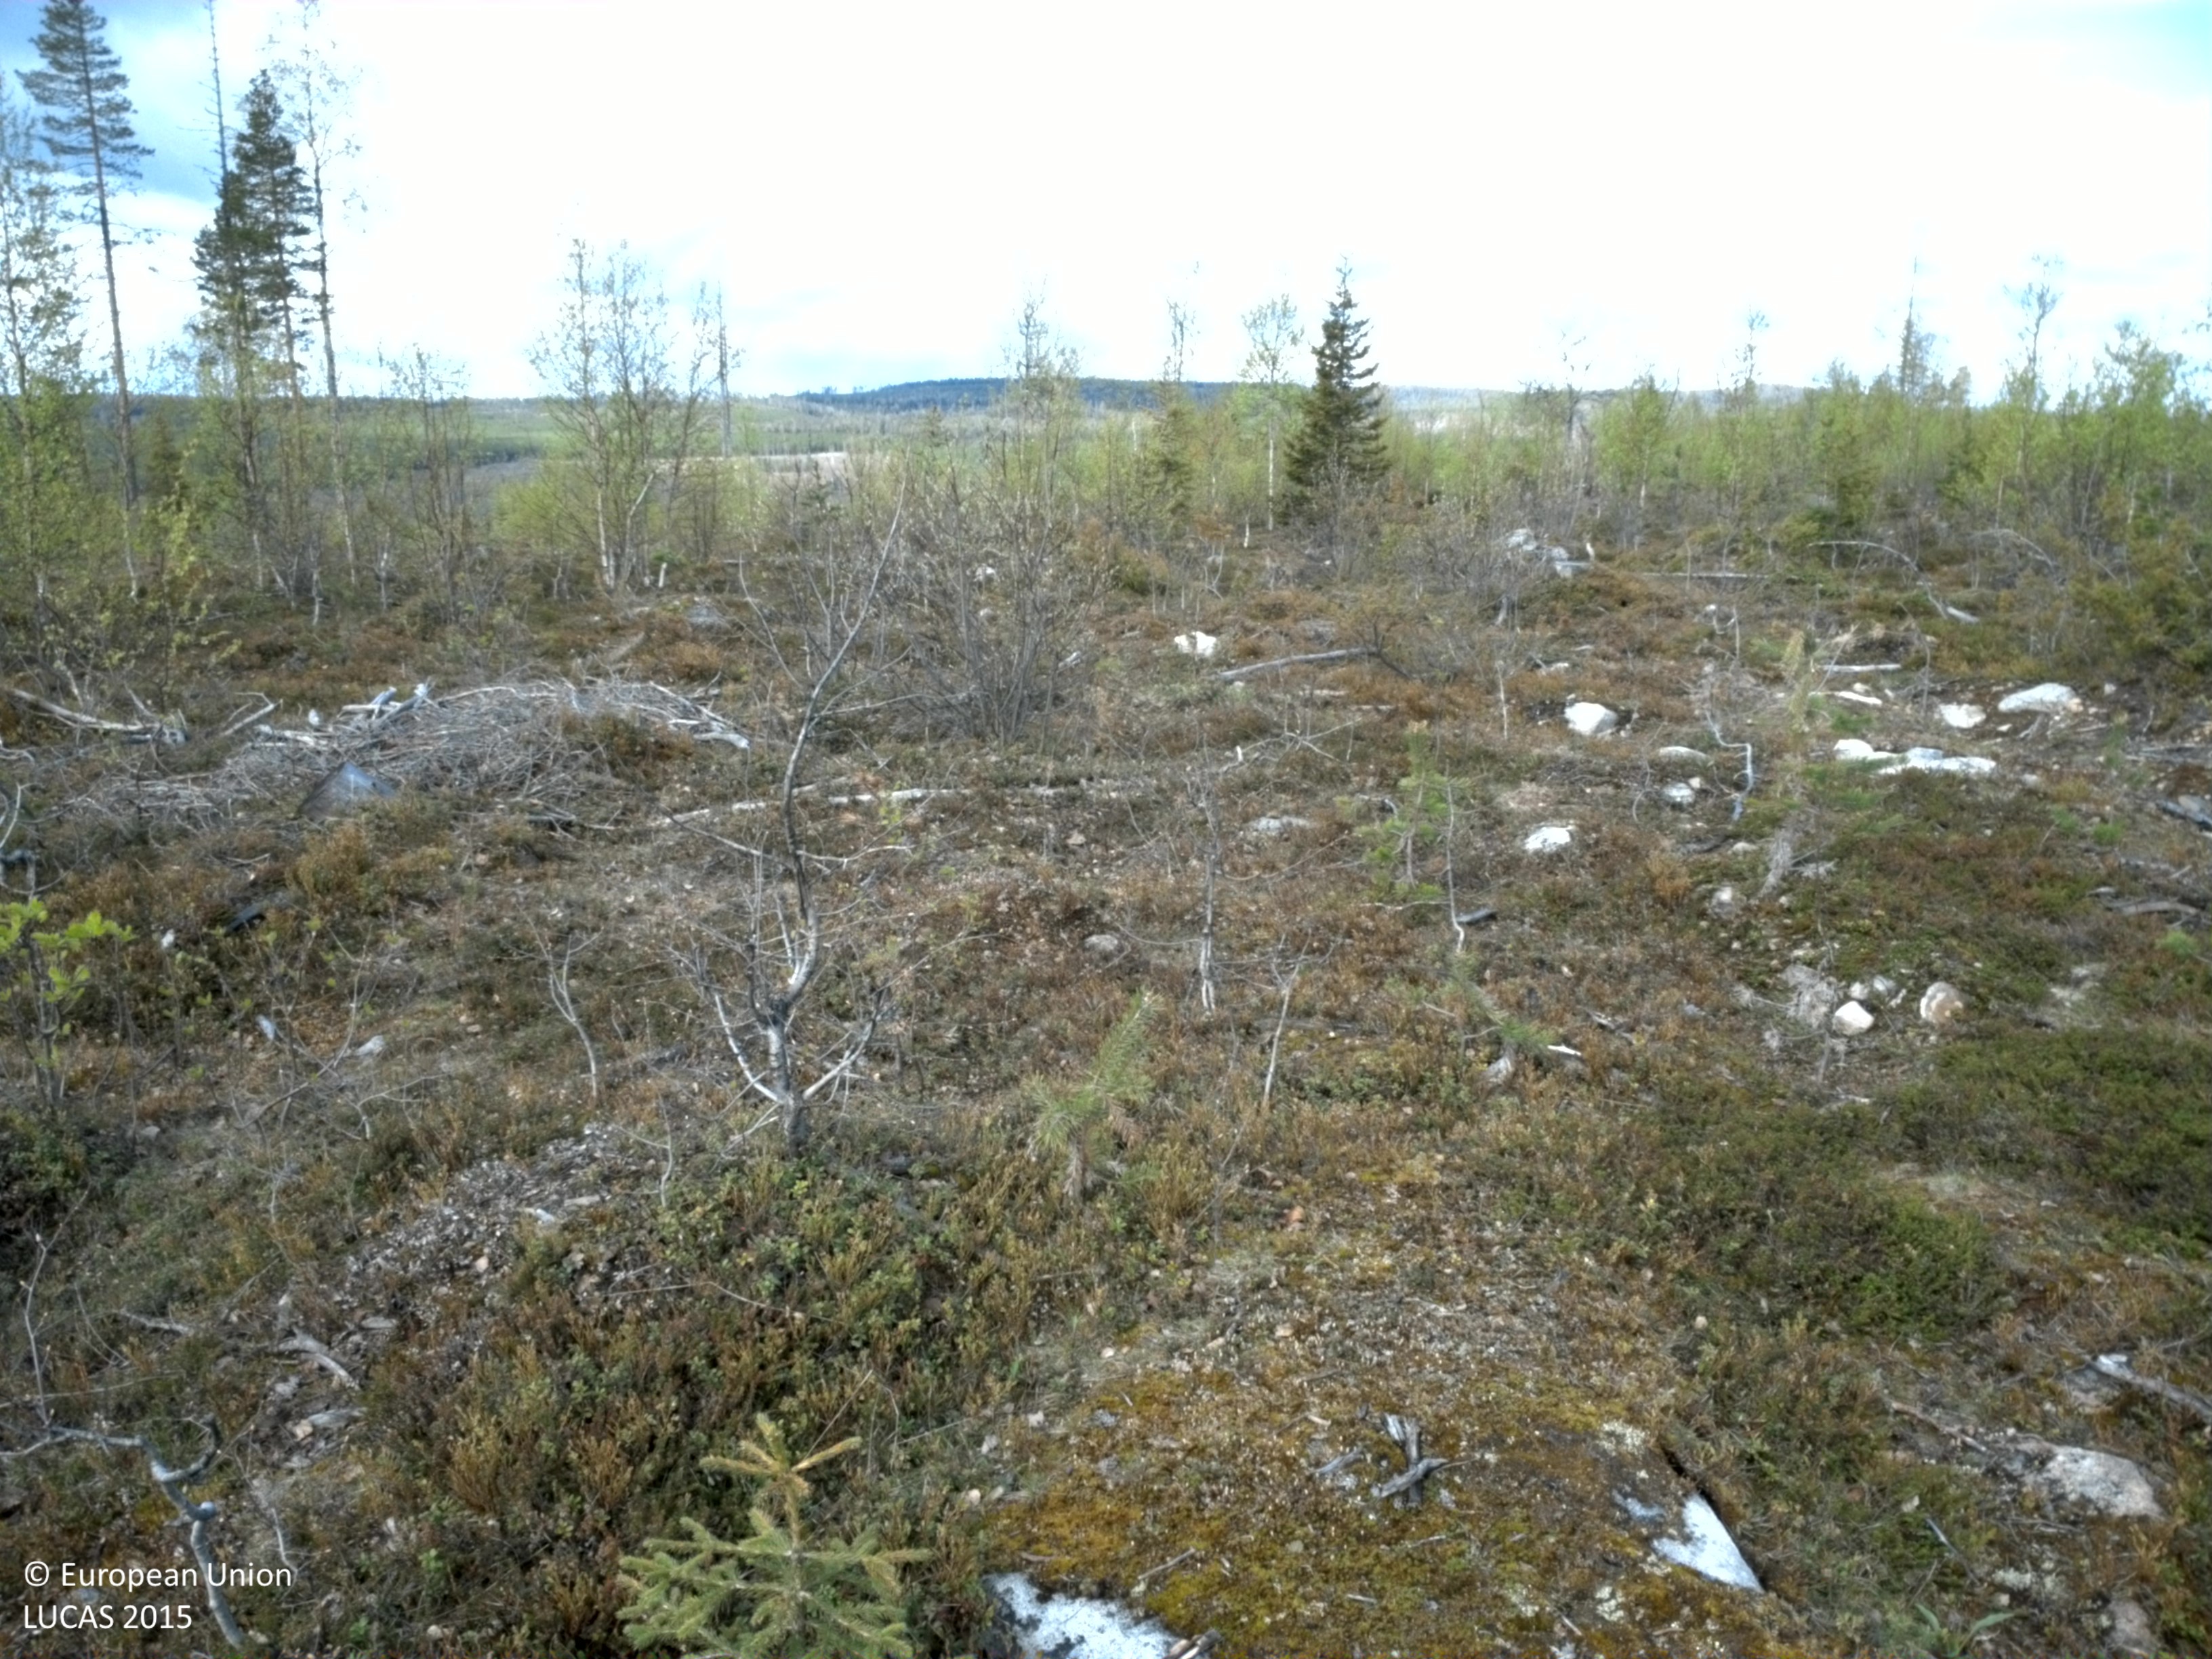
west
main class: Woodland
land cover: Pine dominated mixed woodland
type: boreal forest
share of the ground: 10 - 25 %
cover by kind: shrubs 75 %, broadleaved forest trees 15 %, coniferous forest trees 10 %
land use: Forestry
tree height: < 5 m
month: June
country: SE
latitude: 66.4240
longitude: 23.3594
